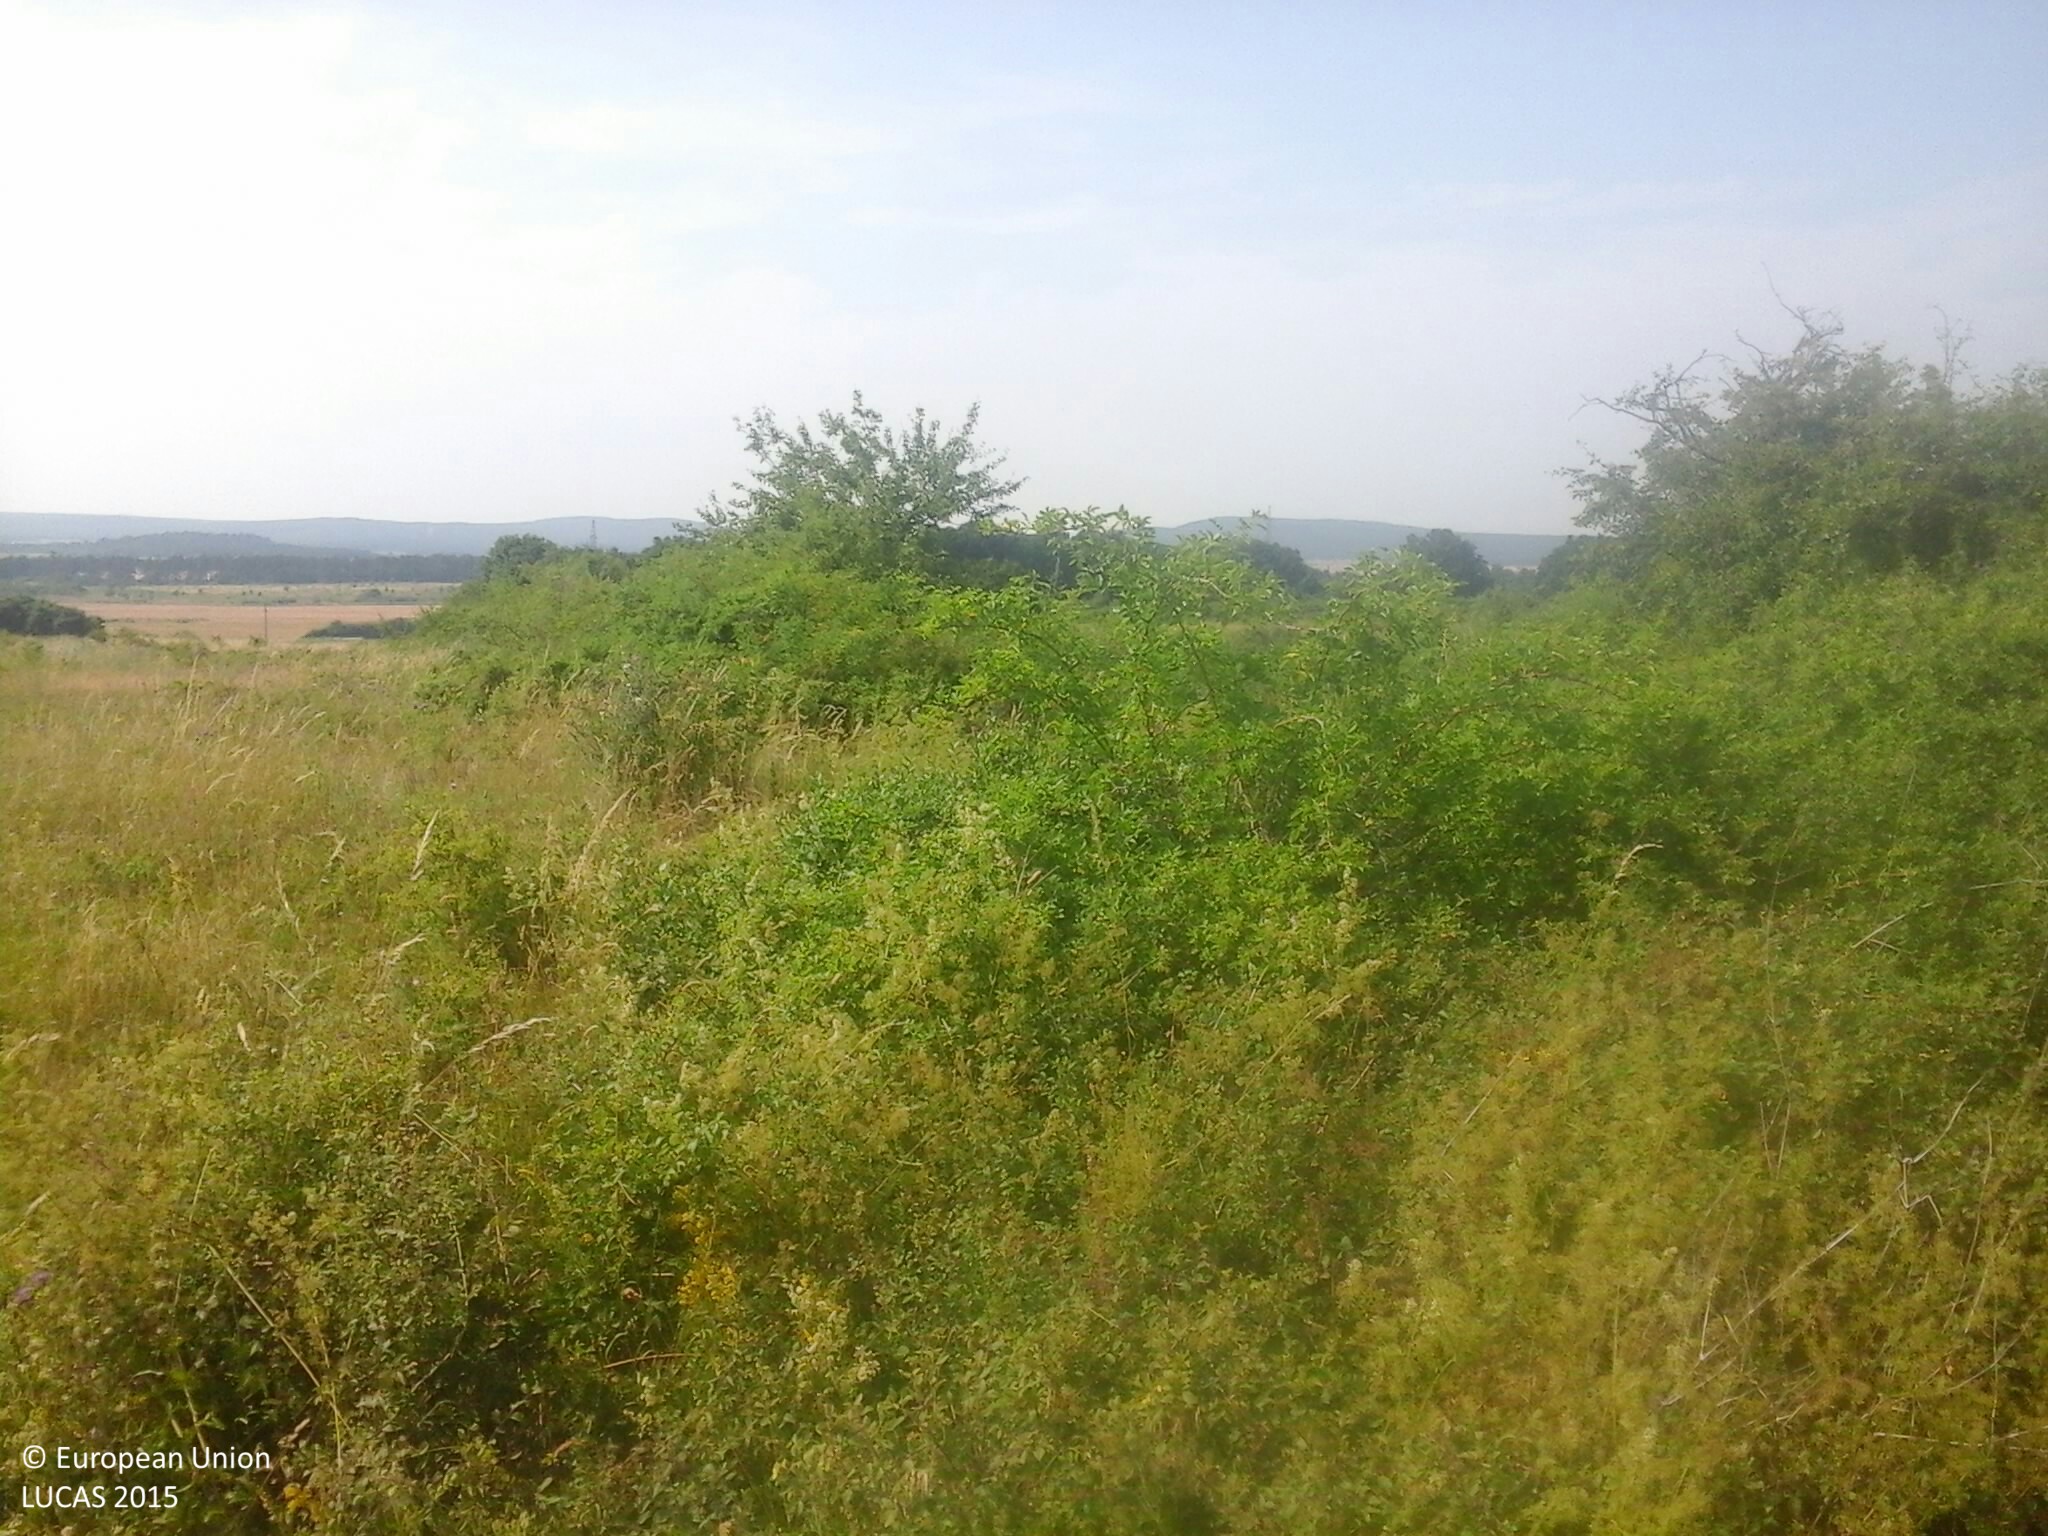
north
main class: Shrubland
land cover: Shrubland without tree cover
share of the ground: > 75 %
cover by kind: shrubs 95 %, herbaceous plants 5 %
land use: Semi-natural and natural areas not in use
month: July
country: HU
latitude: 46.9920
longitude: 17.7526
